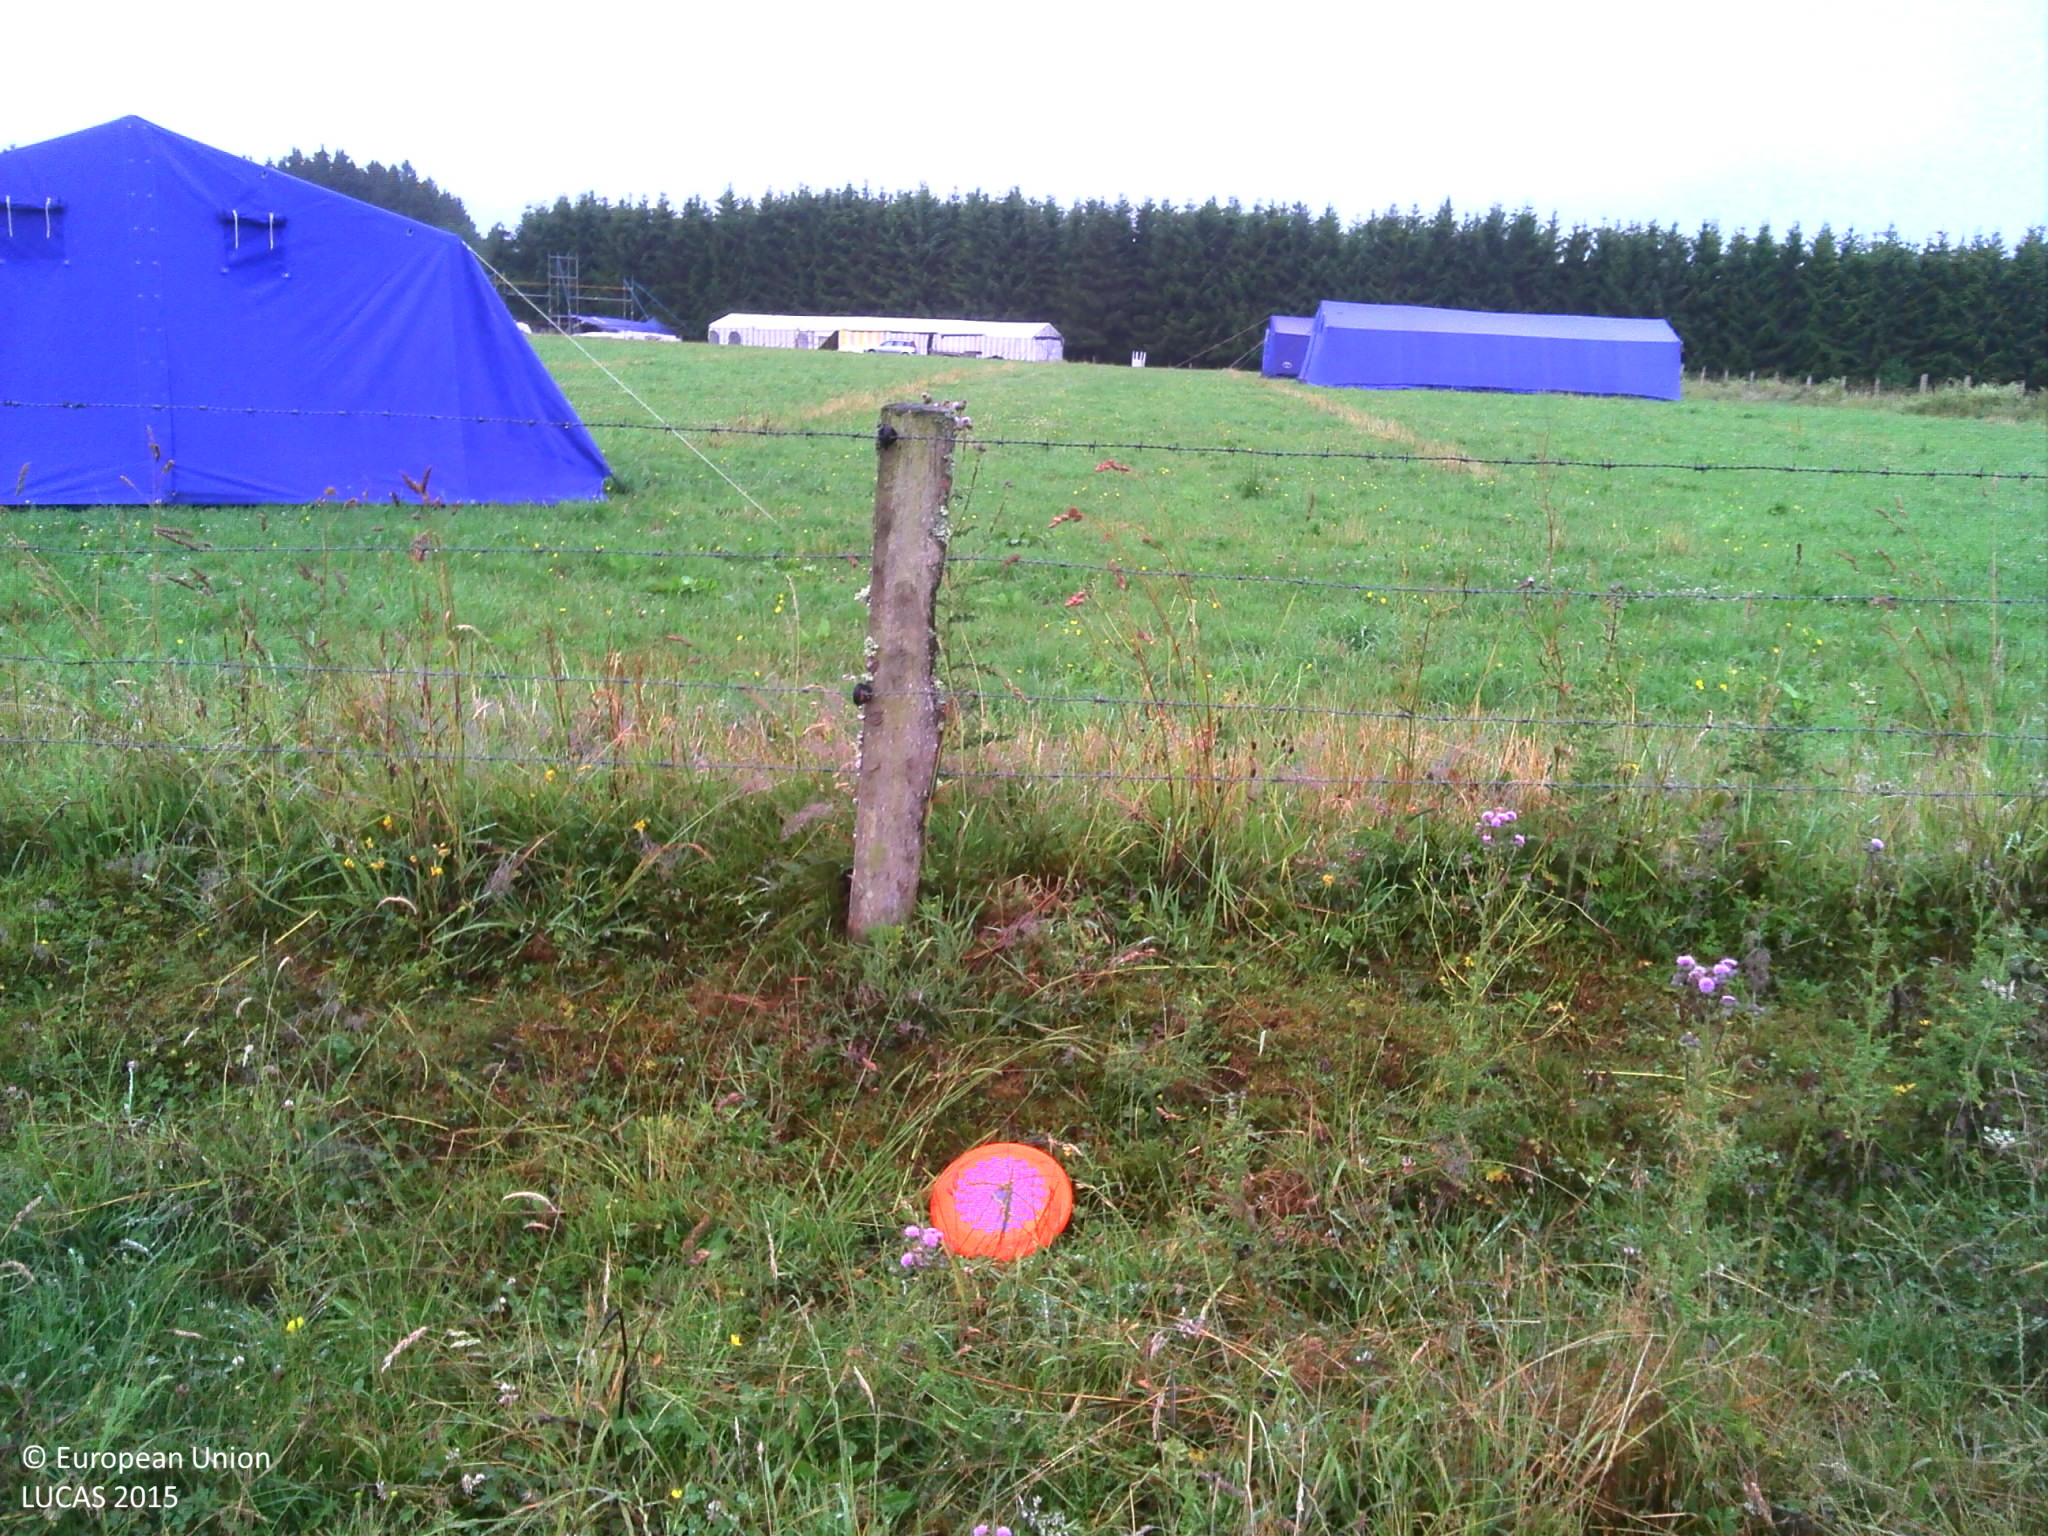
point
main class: Grassland
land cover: Grassland without tree/shrub cover
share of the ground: > 75 %
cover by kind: herbaceous plants 100 %
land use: Agriculture (excluding fallow land and kitchen gardens)
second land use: Amenities, museums, leisure
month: July
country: BE
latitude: 50.1583
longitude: 5.7295
